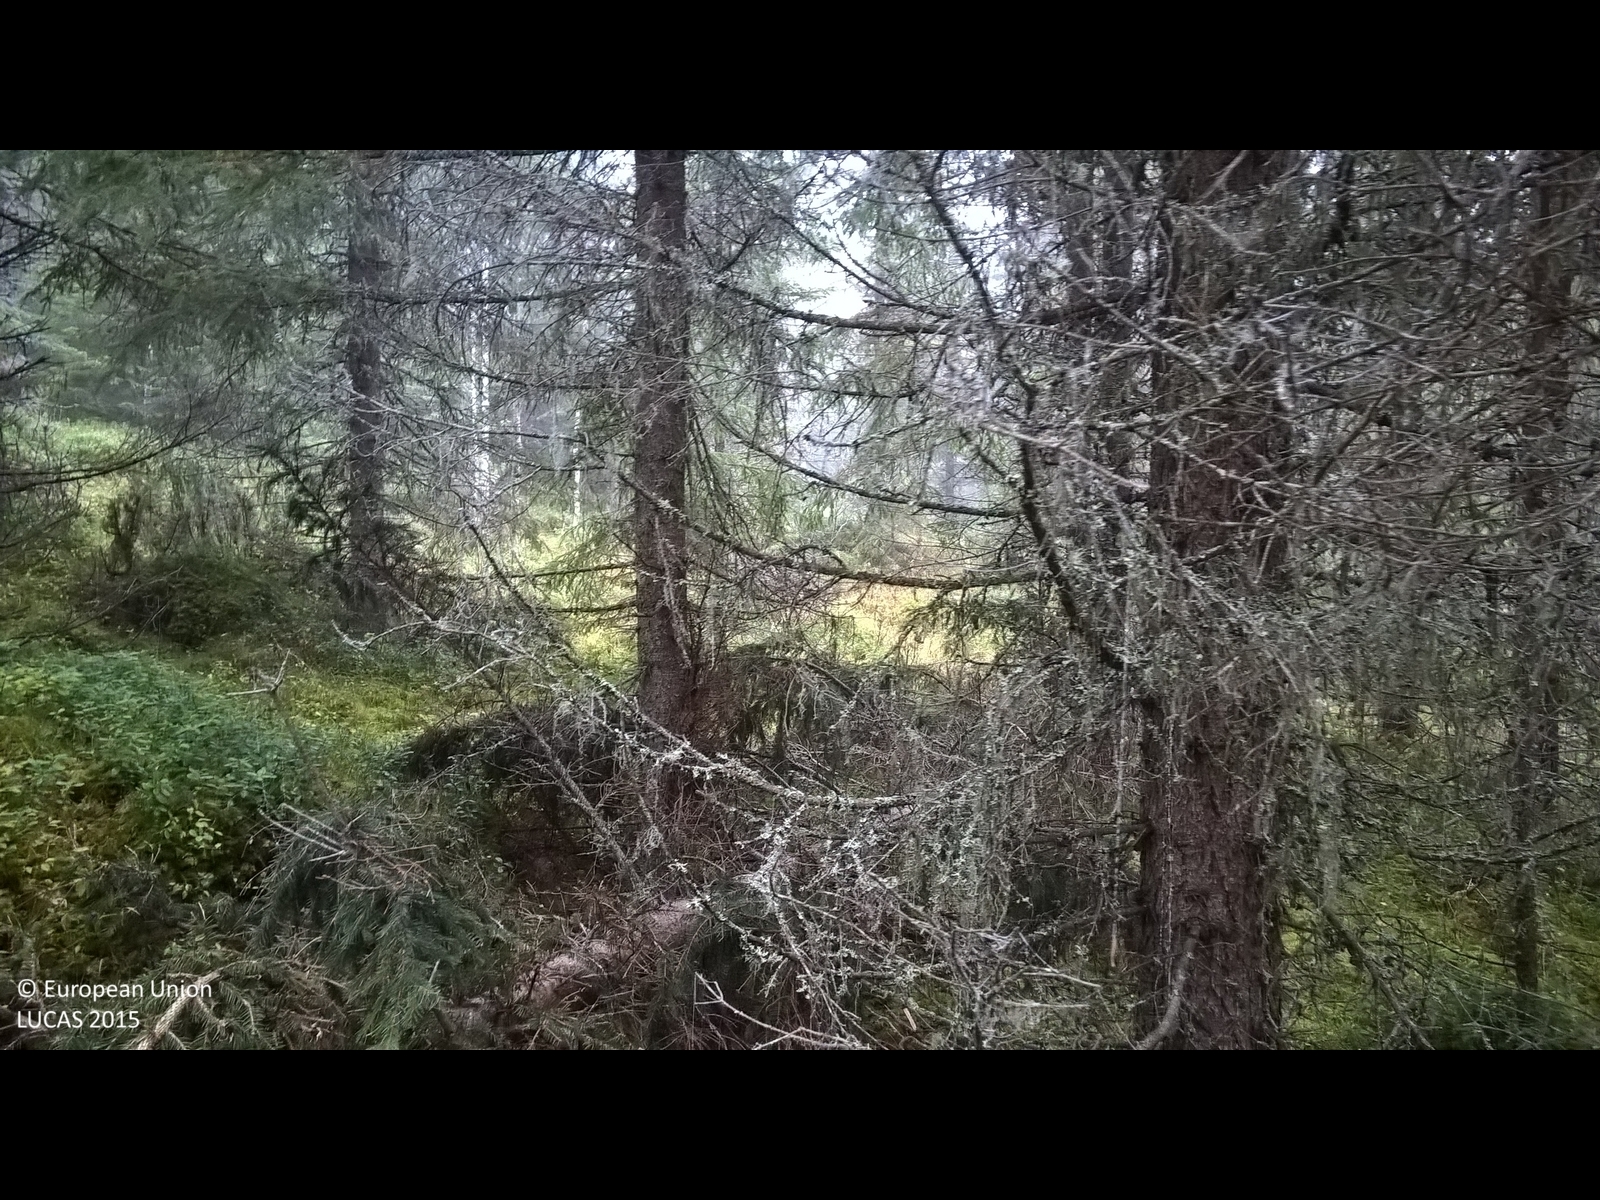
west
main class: Woodland
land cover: Spruce dominated coniferous woodland
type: boreal forest
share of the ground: > 75 %
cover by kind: coniferous forest trees 85 %, lichens and mosses 15 %
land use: Forestry
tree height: > 5 m
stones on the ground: < 10 %
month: October
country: SE
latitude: 62.9461
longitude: 14.9648
